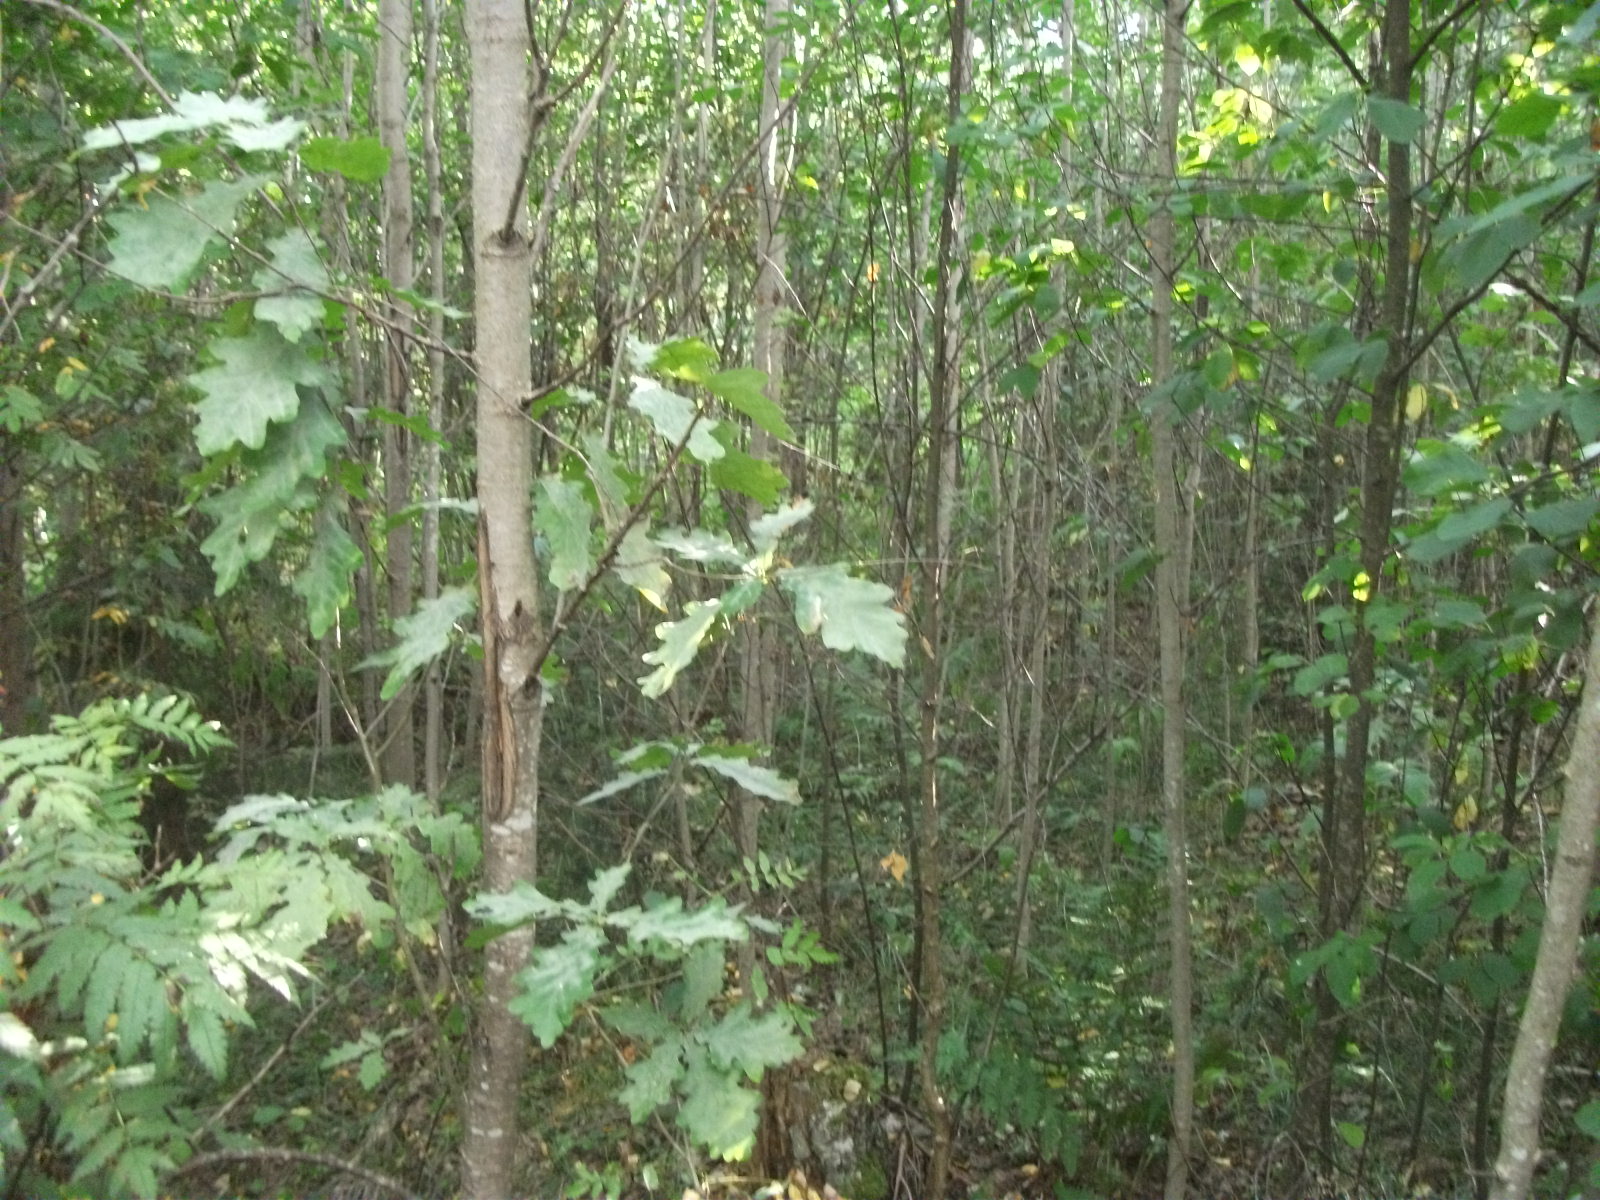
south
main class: Woodland
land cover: Broadleaved woodland
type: non-riverine alder, birch or aspen forest
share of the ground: > 75 %
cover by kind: broadleaved forest trees 90 %, shrubs 10 %
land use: Forestry
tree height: > 5 m
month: August
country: LV
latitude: 56.3827
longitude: 26.3224
